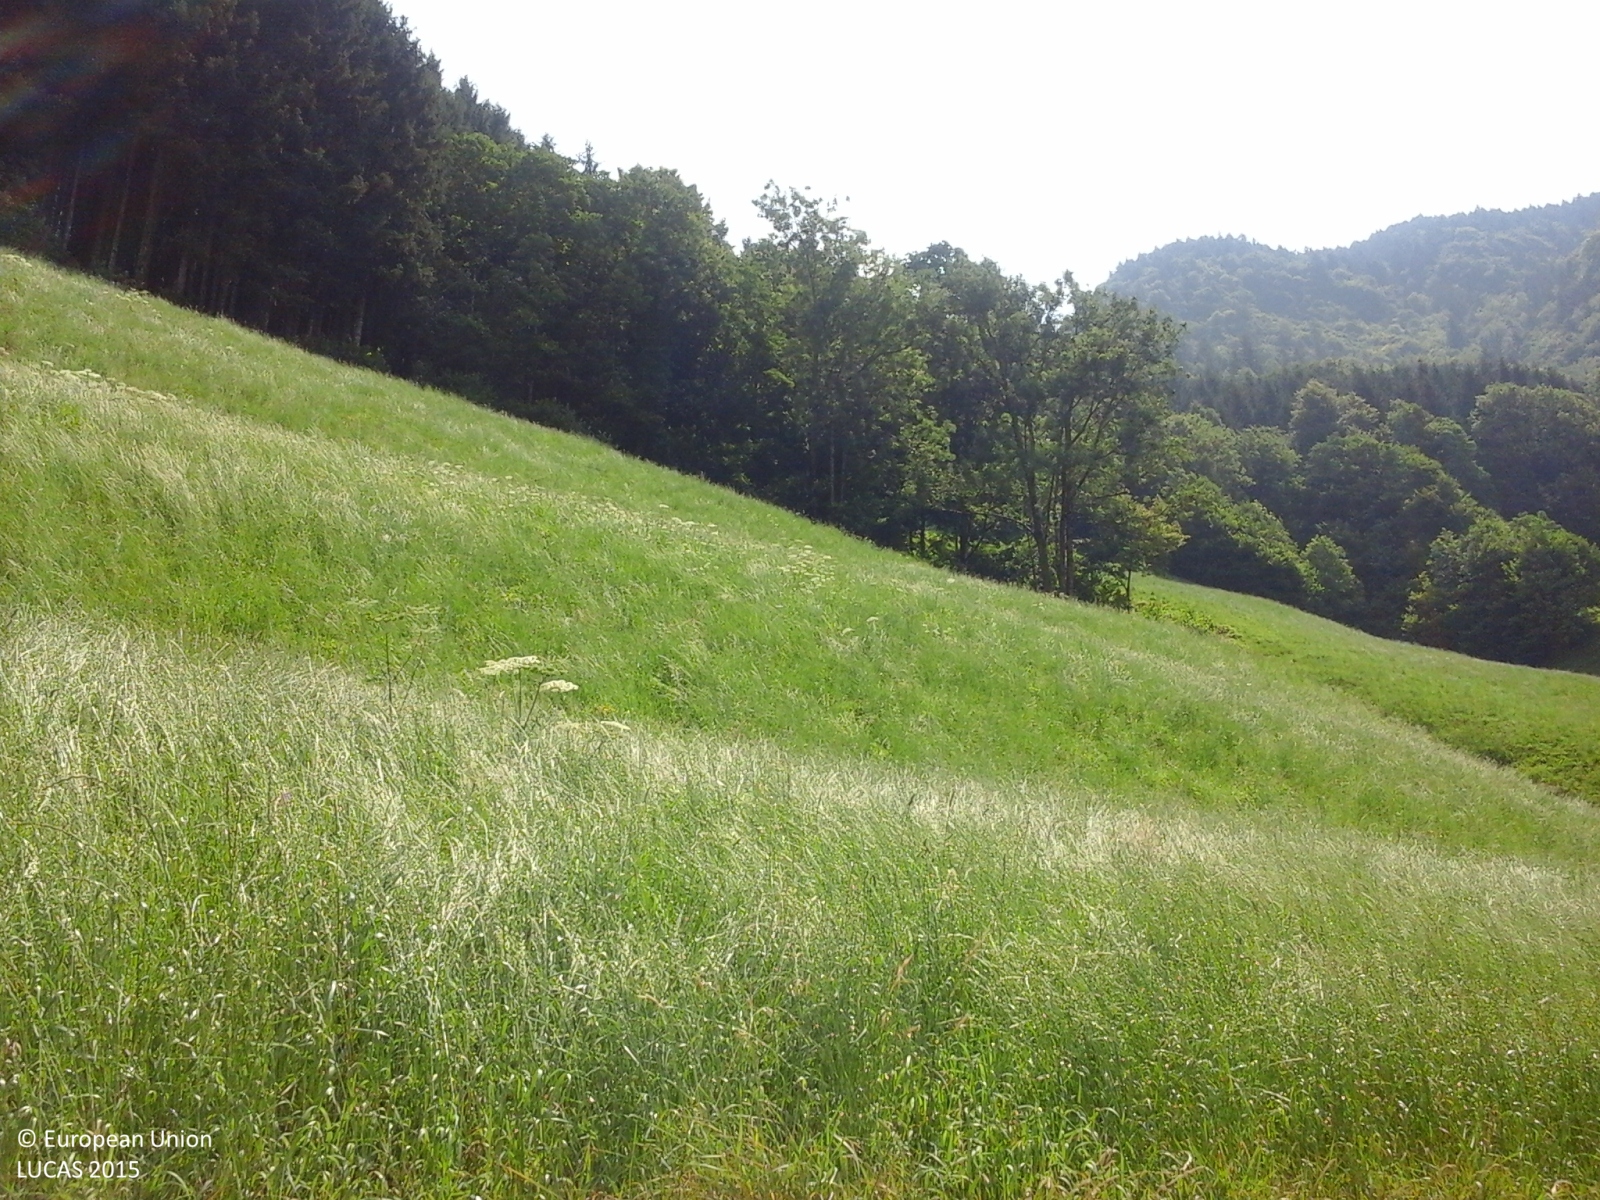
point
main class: Grassland
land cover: Grassland without tree/shrub cover
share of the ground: > 75 %
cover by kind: herbaceous plants 100 %
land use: Agriculture (excluding fallow land and kitchen gardens)
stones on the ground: < 10 %
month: July
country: IT
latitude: 45.9368
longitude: 9.9356
